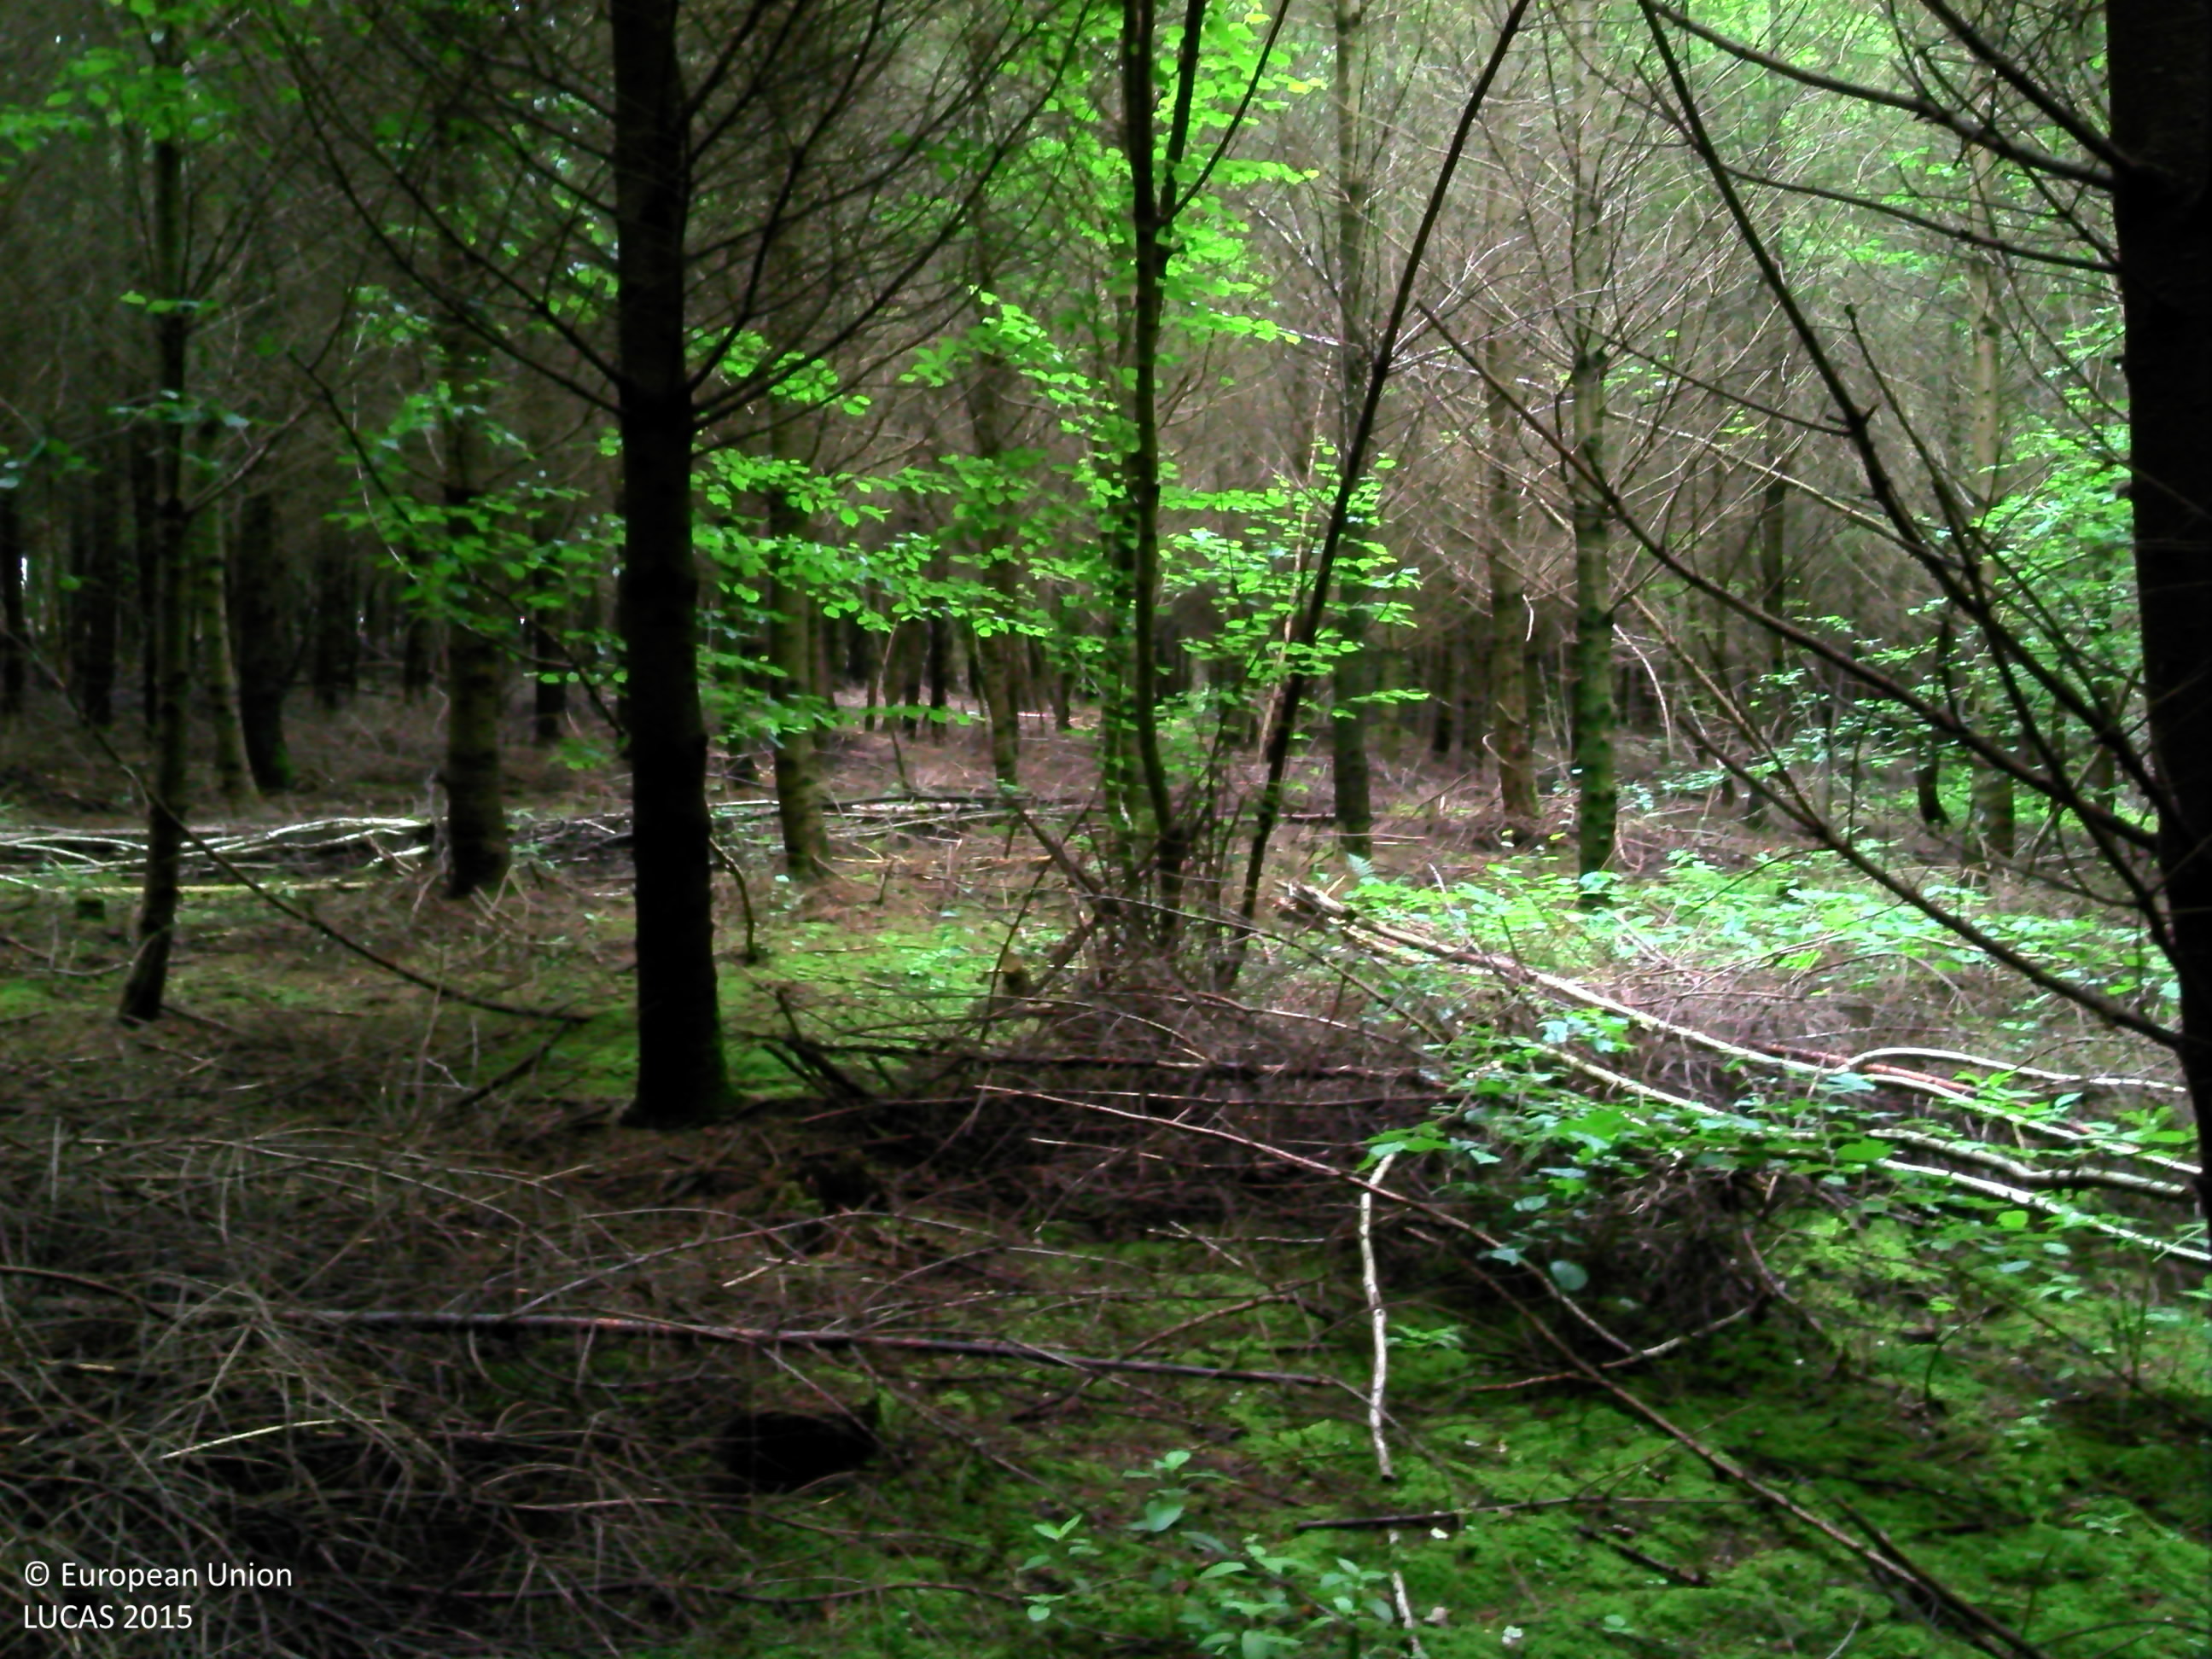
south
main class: Woodland
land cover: Spruce dominated coniferous woodland
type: exotic forest
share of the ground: > 75 %
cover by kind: coniferous forest trees 80 %, broadleaved forest trees 10 %, lichens and mosses 10 %
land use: Forestry
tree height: > 5 m
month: June
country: BE
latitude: 50.4906
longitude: 5.4735
